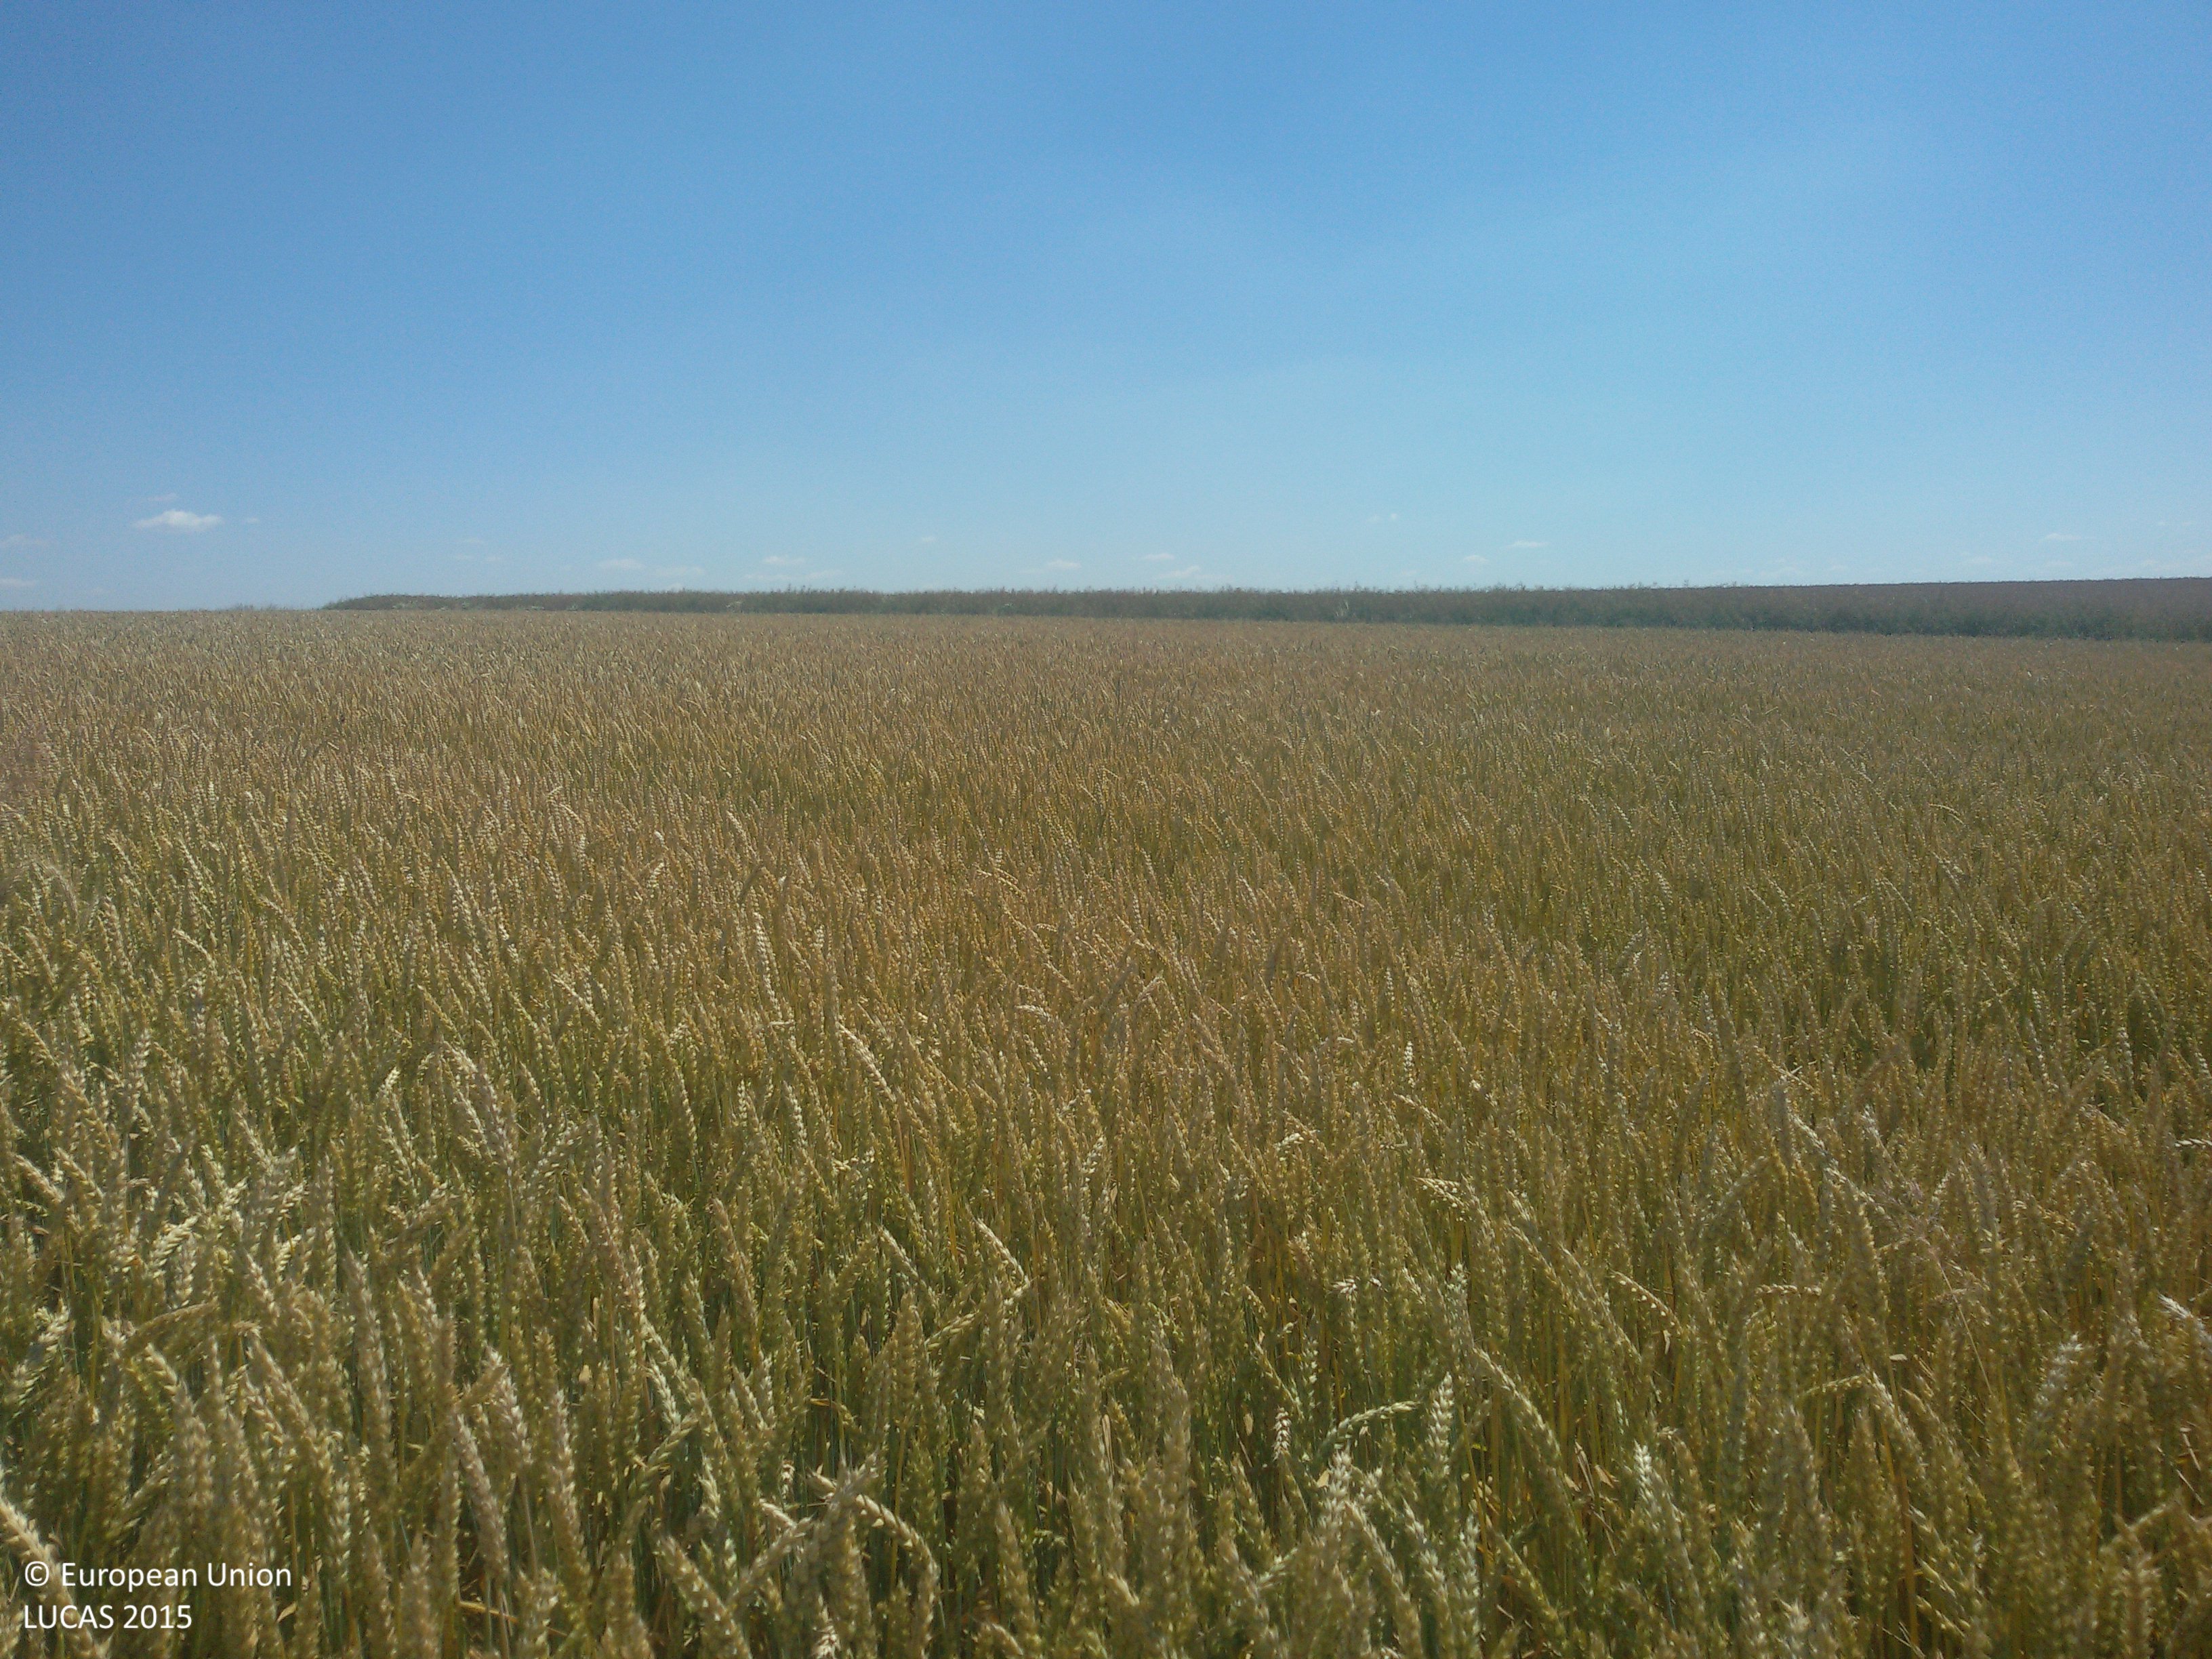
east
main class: Cropland
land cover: Common wheat
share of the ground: > 75 %
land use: Agriculture (excluding fallow land and kitchen gardens)
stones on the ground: < 10 %
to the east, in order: Common wheat; Rape and turnip rape; Grass margins; Tracks; Common wheat; Rape and turnip rape
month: July
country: PL
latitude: 50.3984
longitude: 17.6242
